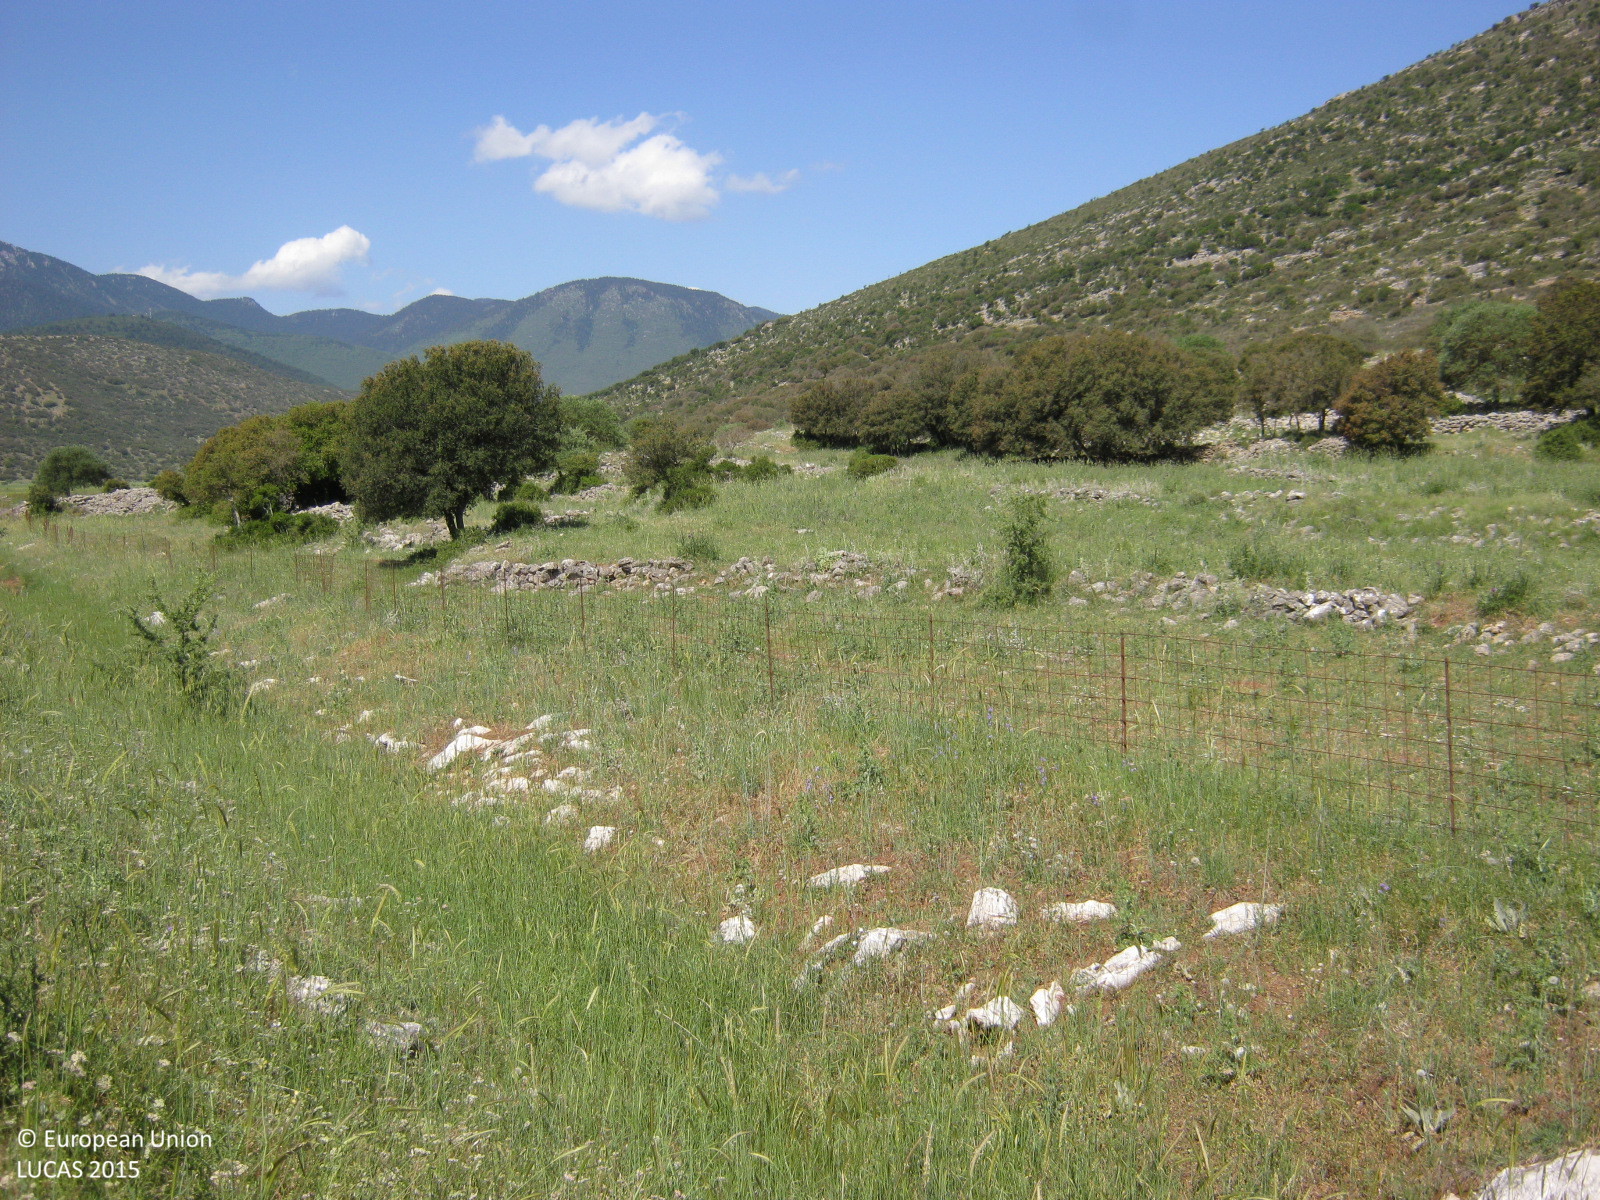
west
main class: Grassland
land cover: Grassland with sparse tree/shrub cover
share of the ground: > 75 %
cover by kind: herbaceous plants 90 %, broadleaved forest trees 5 %, shrubs 5 %
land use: Agriculture (excluding fallow land and kitchen gardens)
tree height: < 5 m
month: May
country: GR
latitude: 37.6892
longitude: 22.3591
